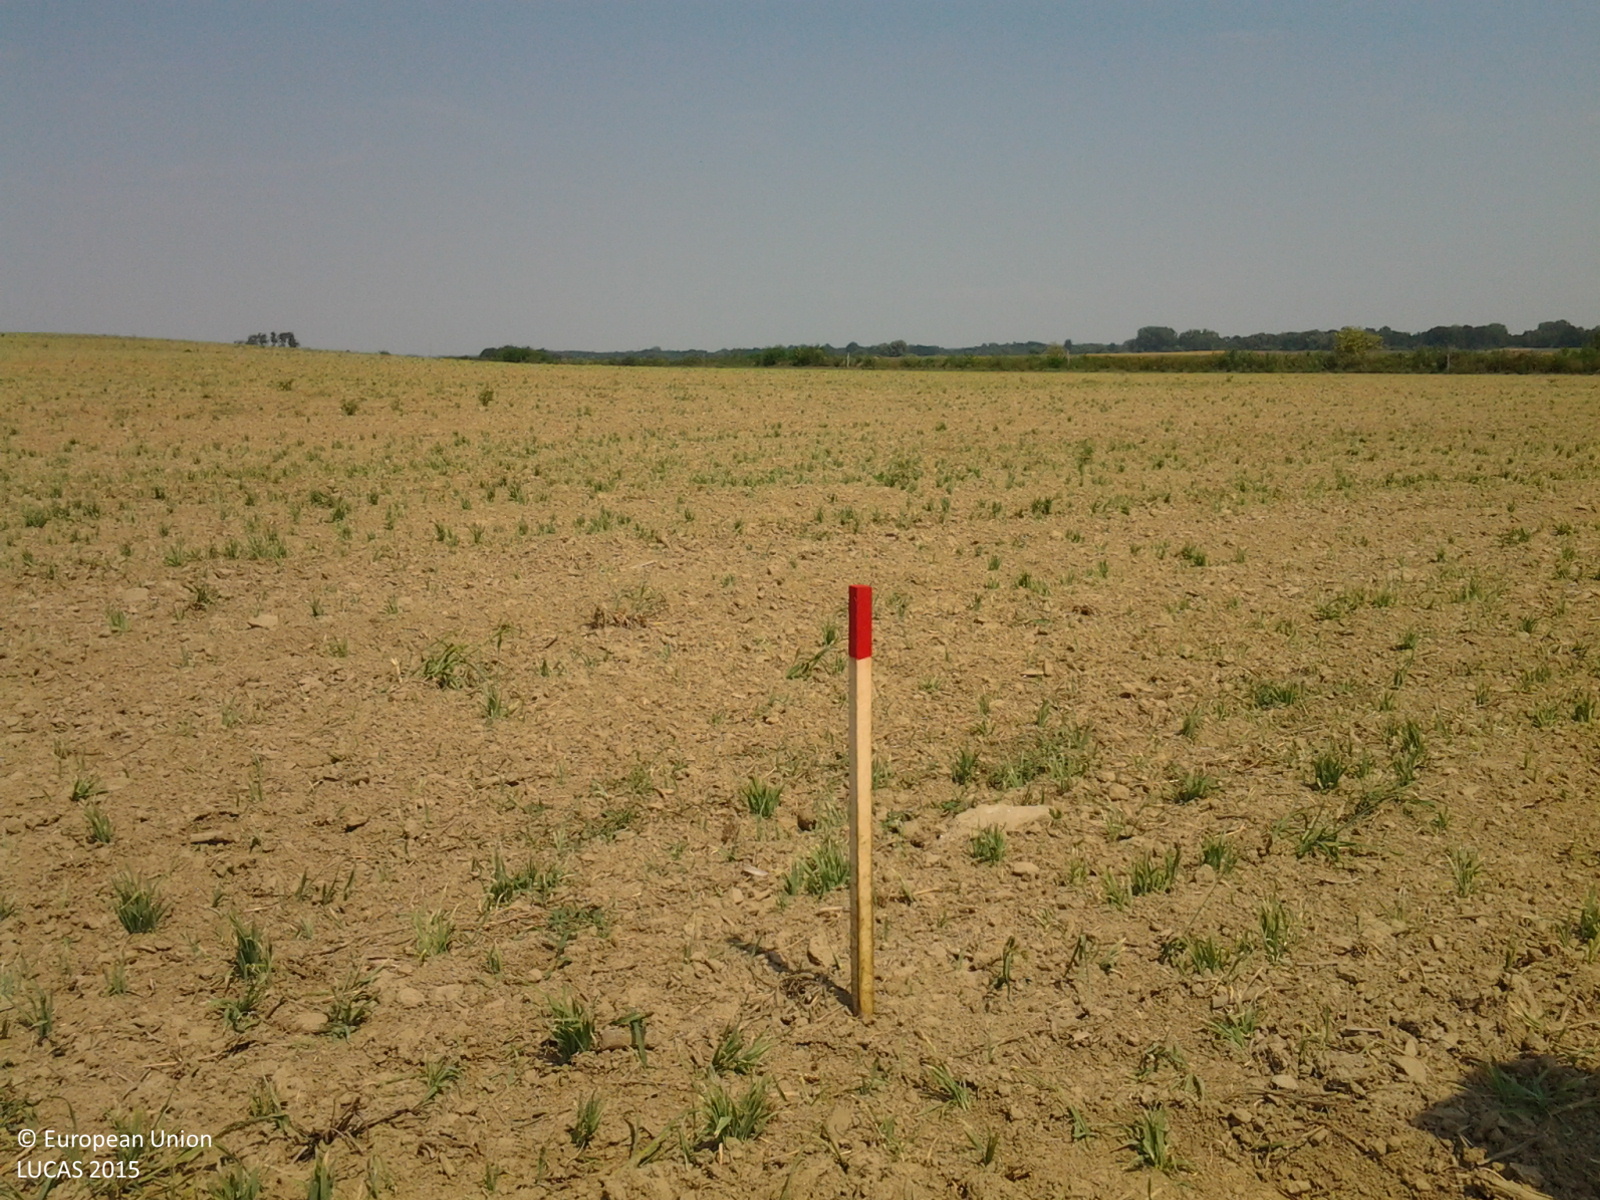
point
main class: Cropland
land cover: Common wheat
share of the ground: < 10 %
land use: Agriculture (excluding fallow land and kitchen gardens)
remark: Harvested field
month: August
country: HU
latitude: 46.1384
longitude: 17.2908
